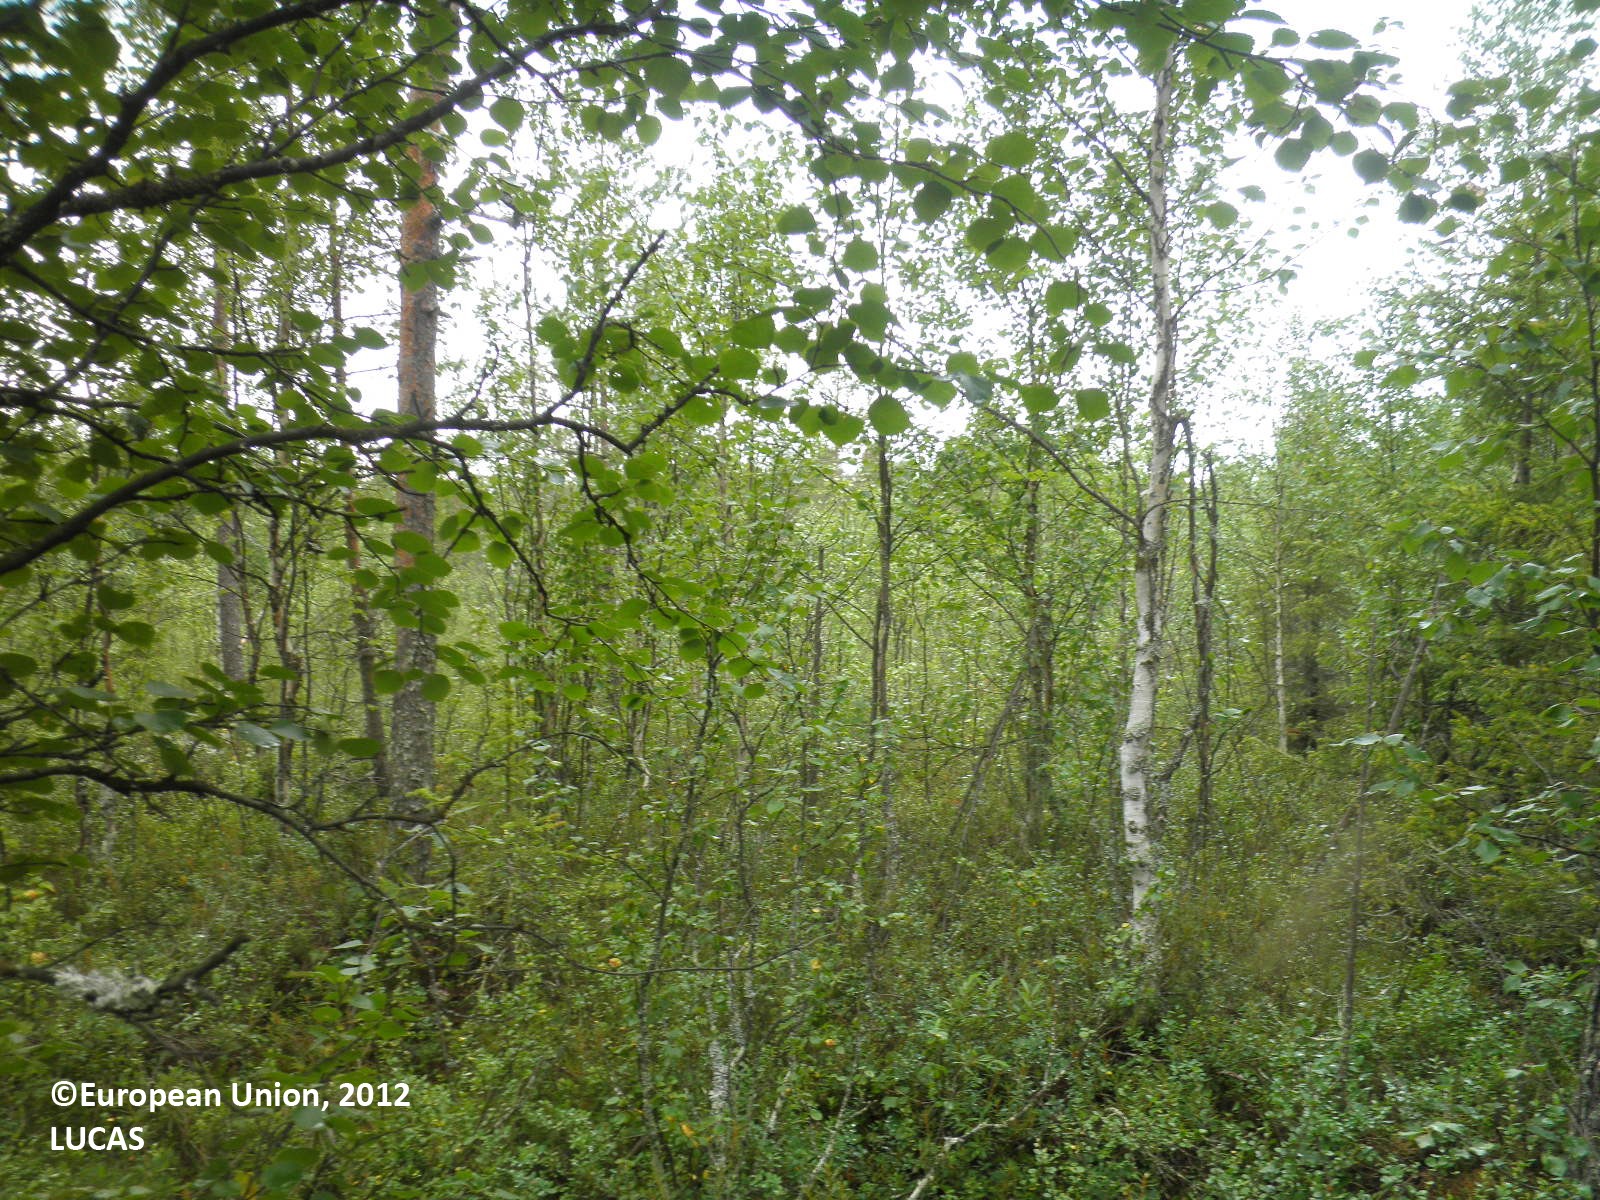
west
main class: Woodland
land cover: Pine dominated mixed woodland
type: boreal forest
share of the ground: 50 - 75 %
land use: Forestry
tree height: > 5 m
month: July
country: FI
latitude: 66.8983
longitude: 28.9040
